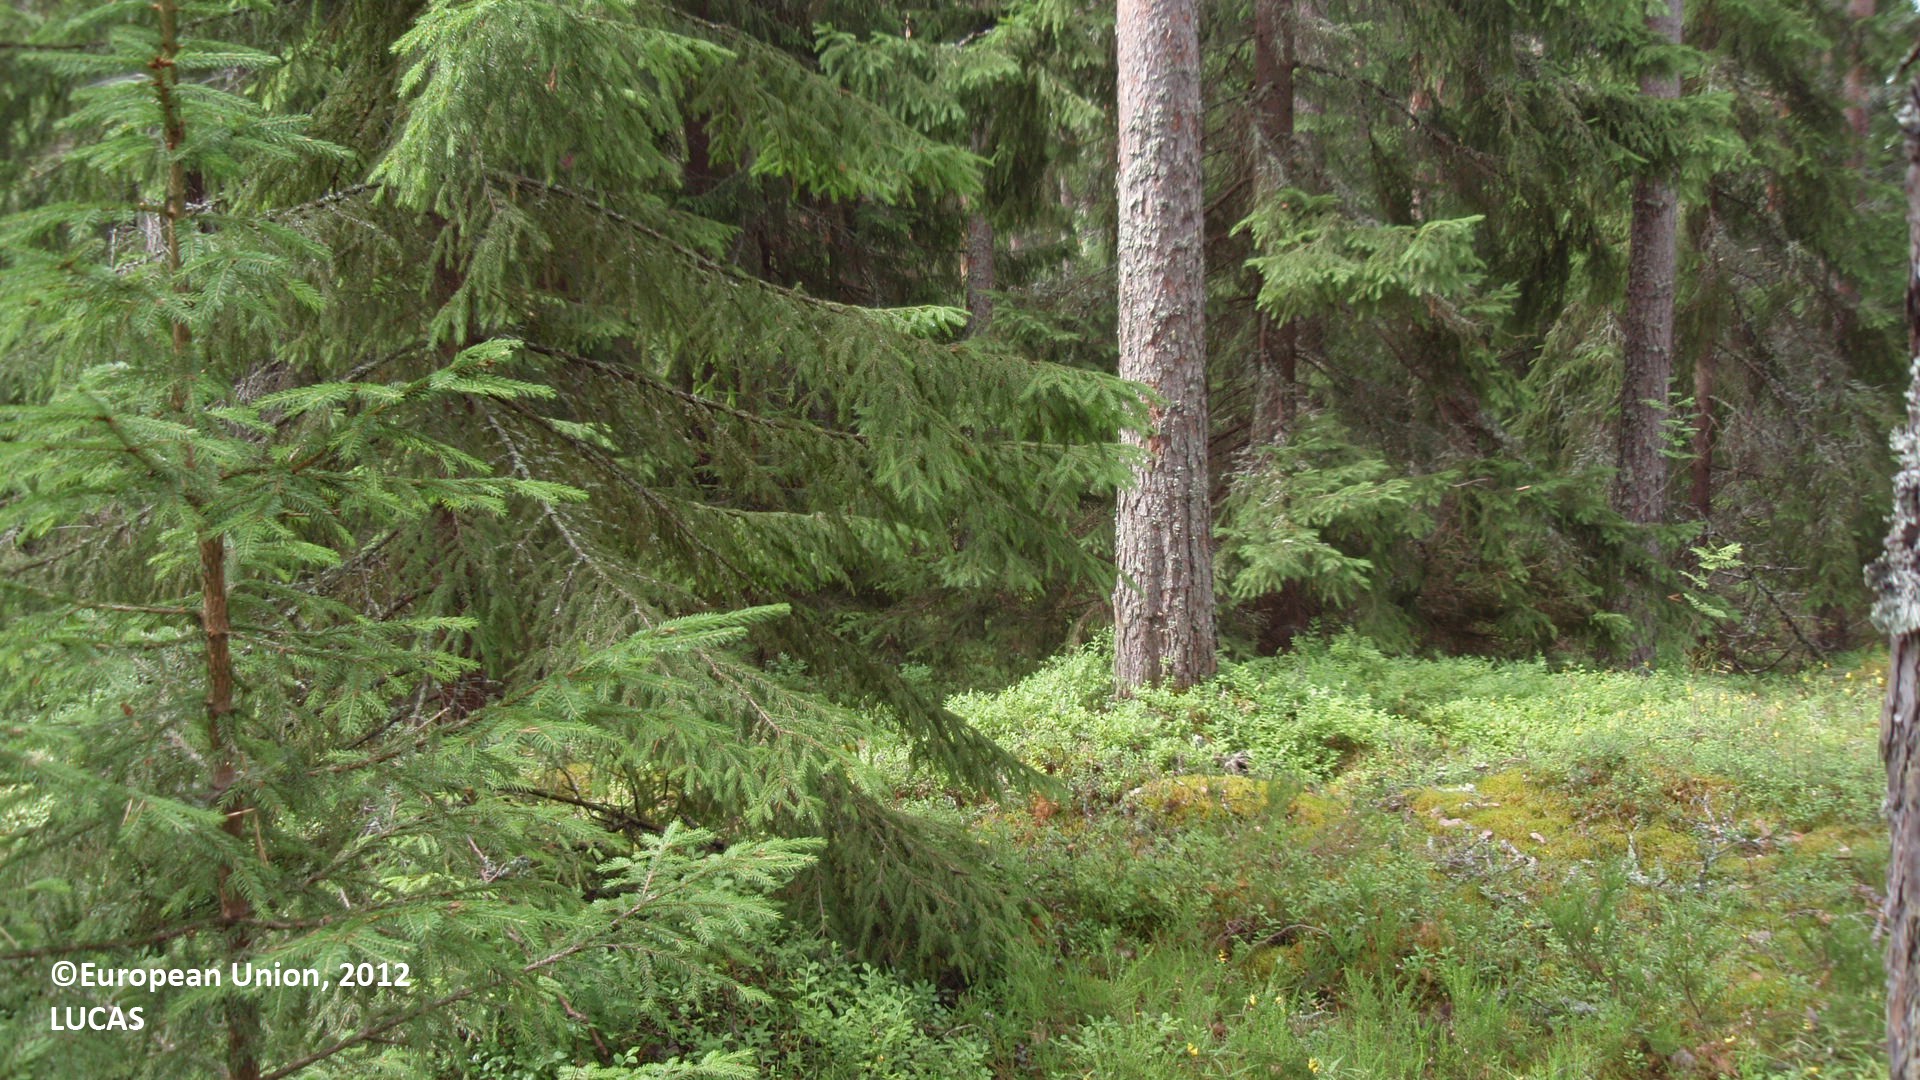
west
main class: Woodland
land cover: Pine dominated mixed woodland
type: boreal forest
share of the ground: 50 - 75 %
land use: Forestry
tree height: > 5 m
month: July
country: FI
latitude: 61.2777
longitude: 28.6690
